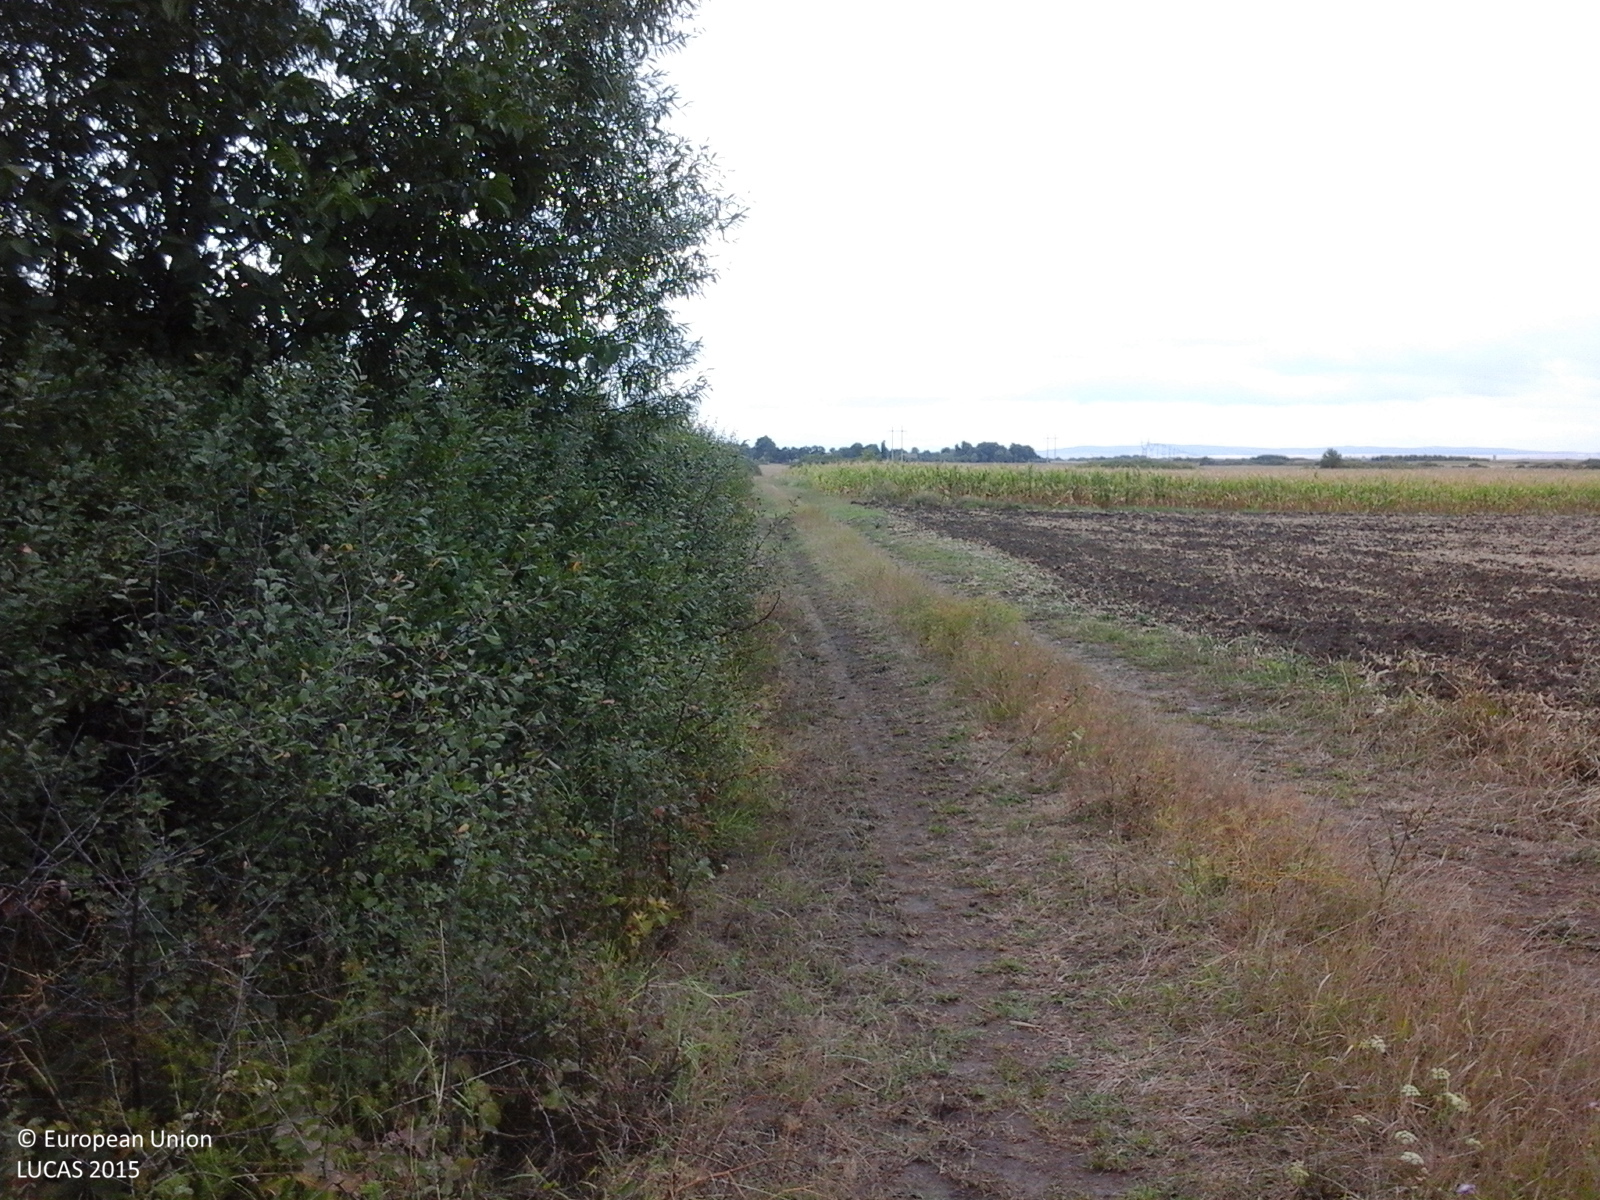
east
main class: Woodland
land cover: Broadleaved woodland
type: exotic forest
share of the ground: > 75 %
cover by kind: broadleaved forest trees 100 %
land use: Forestry
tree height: > 5 m
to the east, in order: Broadleaved woodland; Ditches and canals; Broadleaved woodland; Tracks; Spontaneously vegetated surfaces
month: August
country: RO
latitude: 45.6472
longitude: 21.4133
